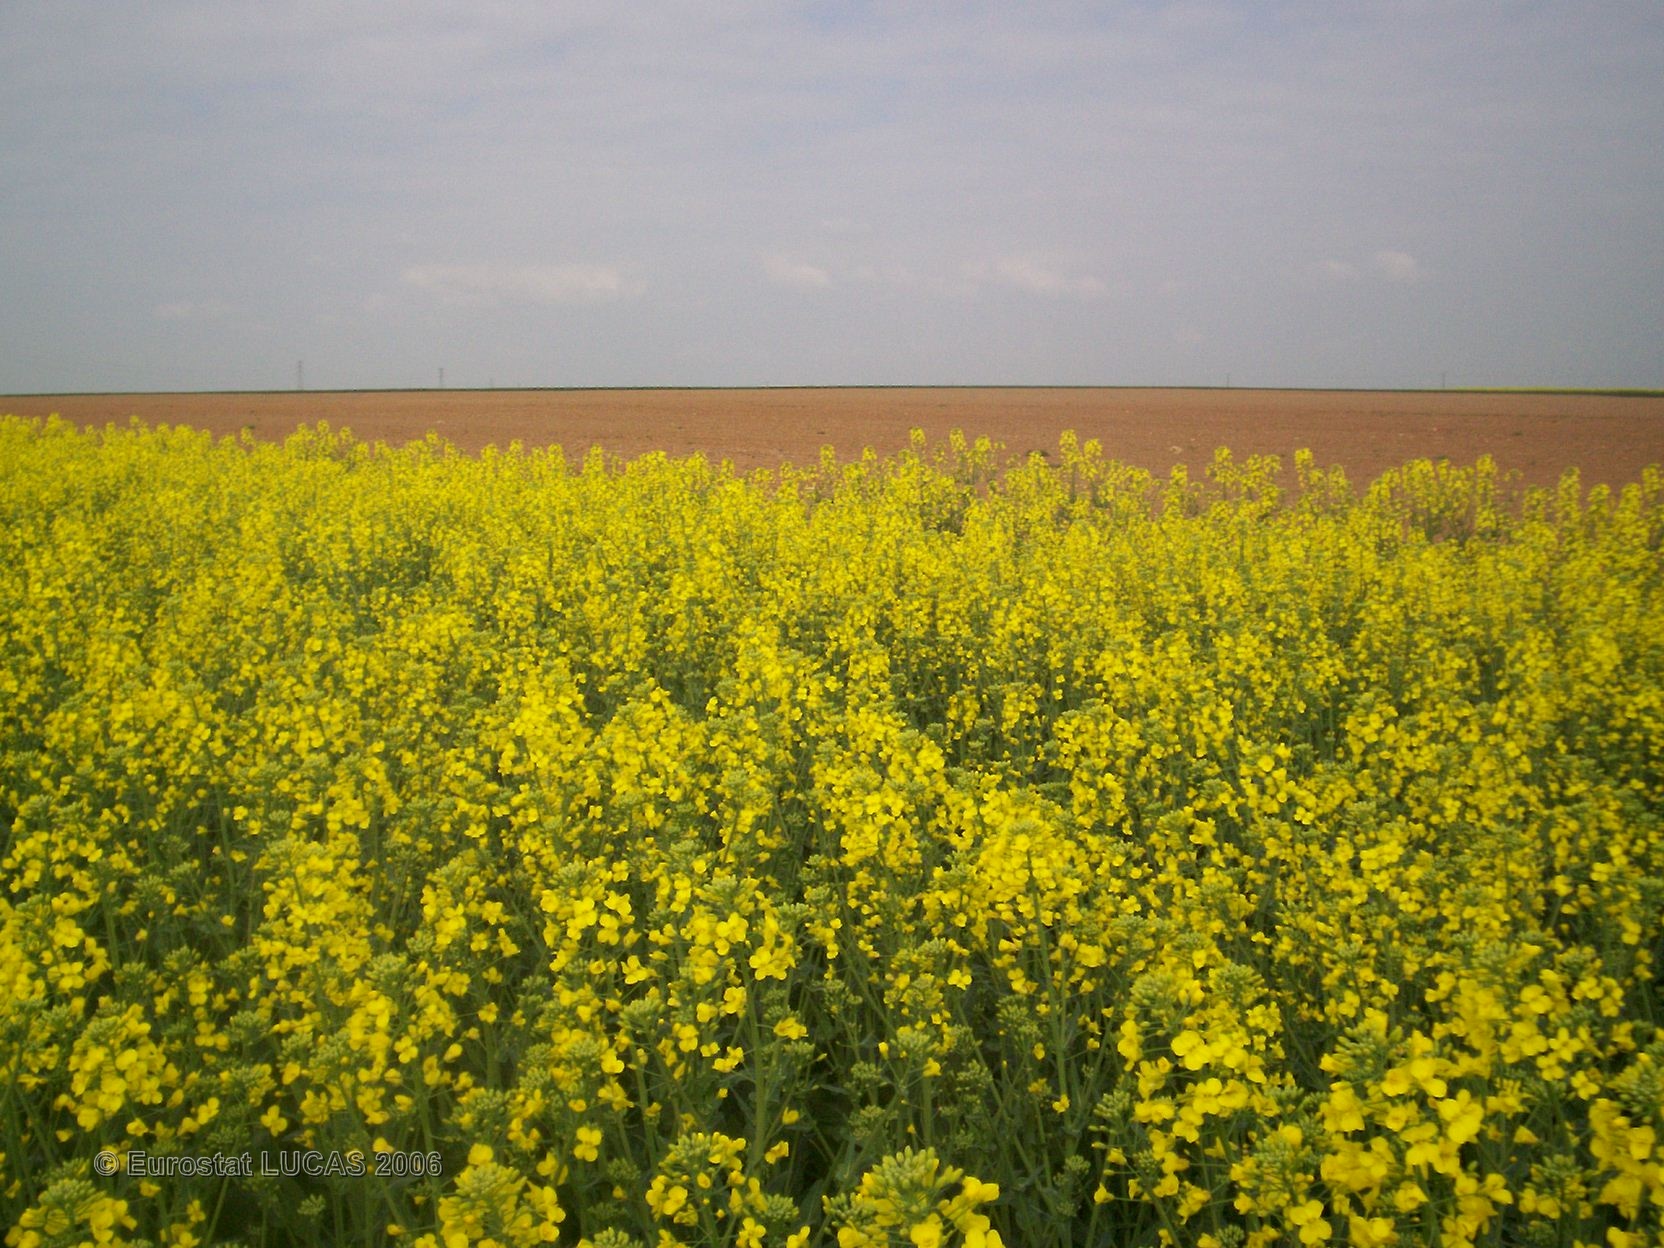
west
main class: Cropland
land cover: Rape and turnip rape
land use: Agriculture (excluding fallow land and kitchen gardens)
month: April
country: FR
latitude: 47.7439
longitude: 1.1941
